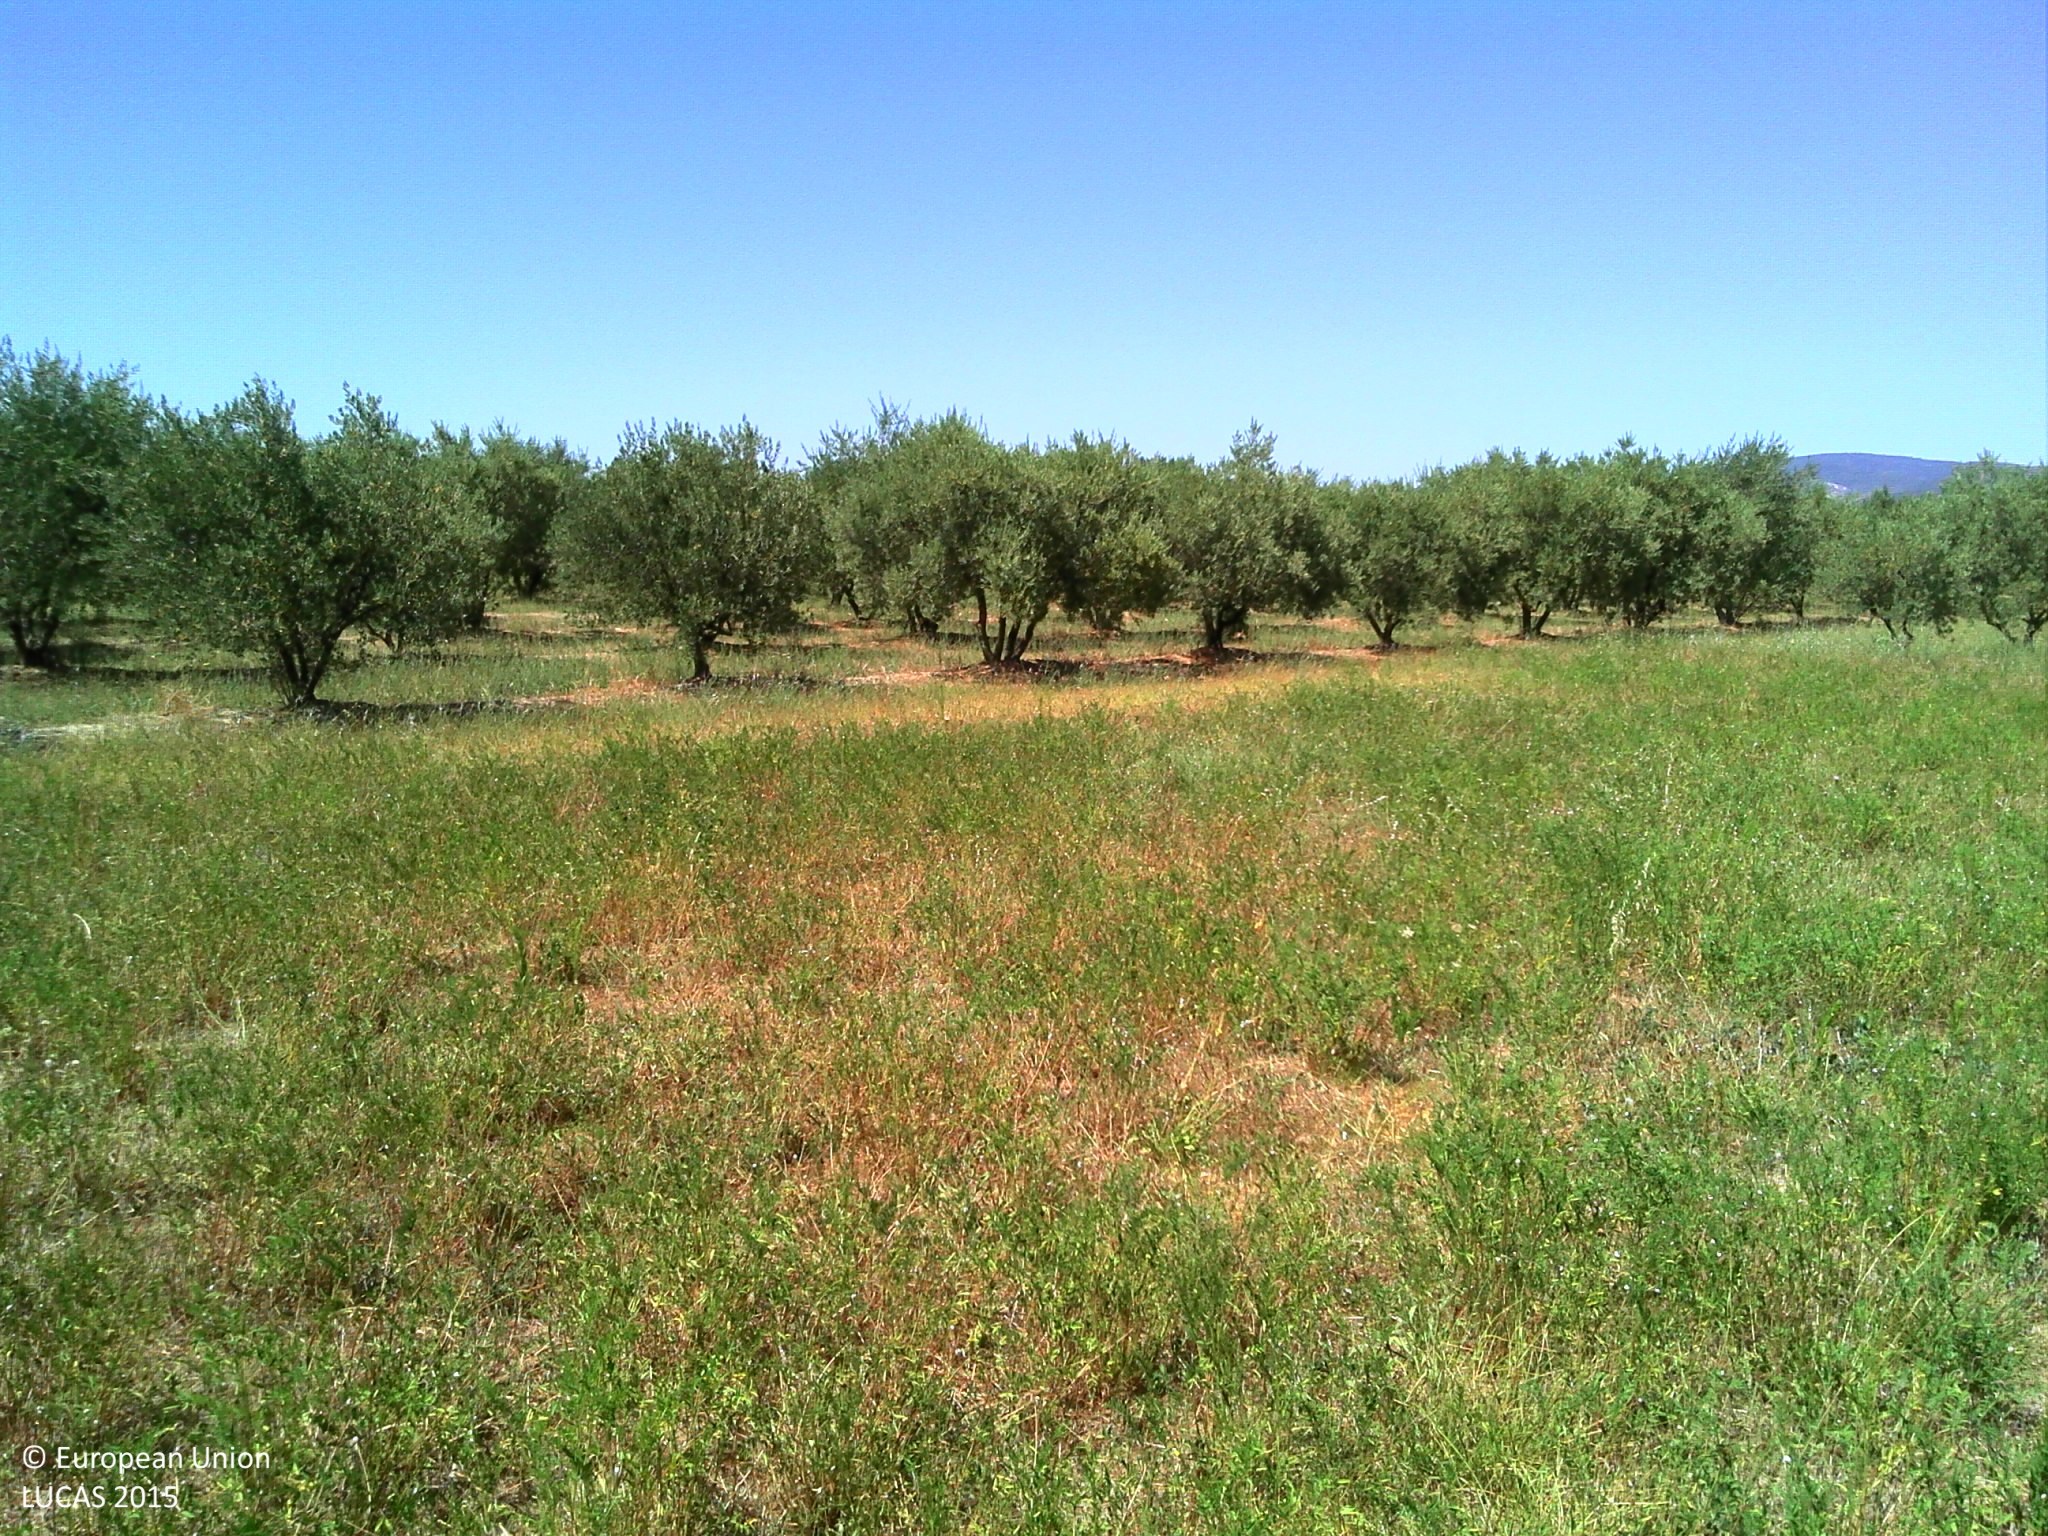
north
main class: Grassland
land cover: Grassland without tree/shrub cover
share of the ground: > 75 %
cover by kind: herbaceous plants 95 %, unconsolidated bare surface 5 %
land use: Agriculture (excluding fallow land and kitchen gardens)
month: July
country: FR
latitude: 43.8371
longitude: 5.0963
